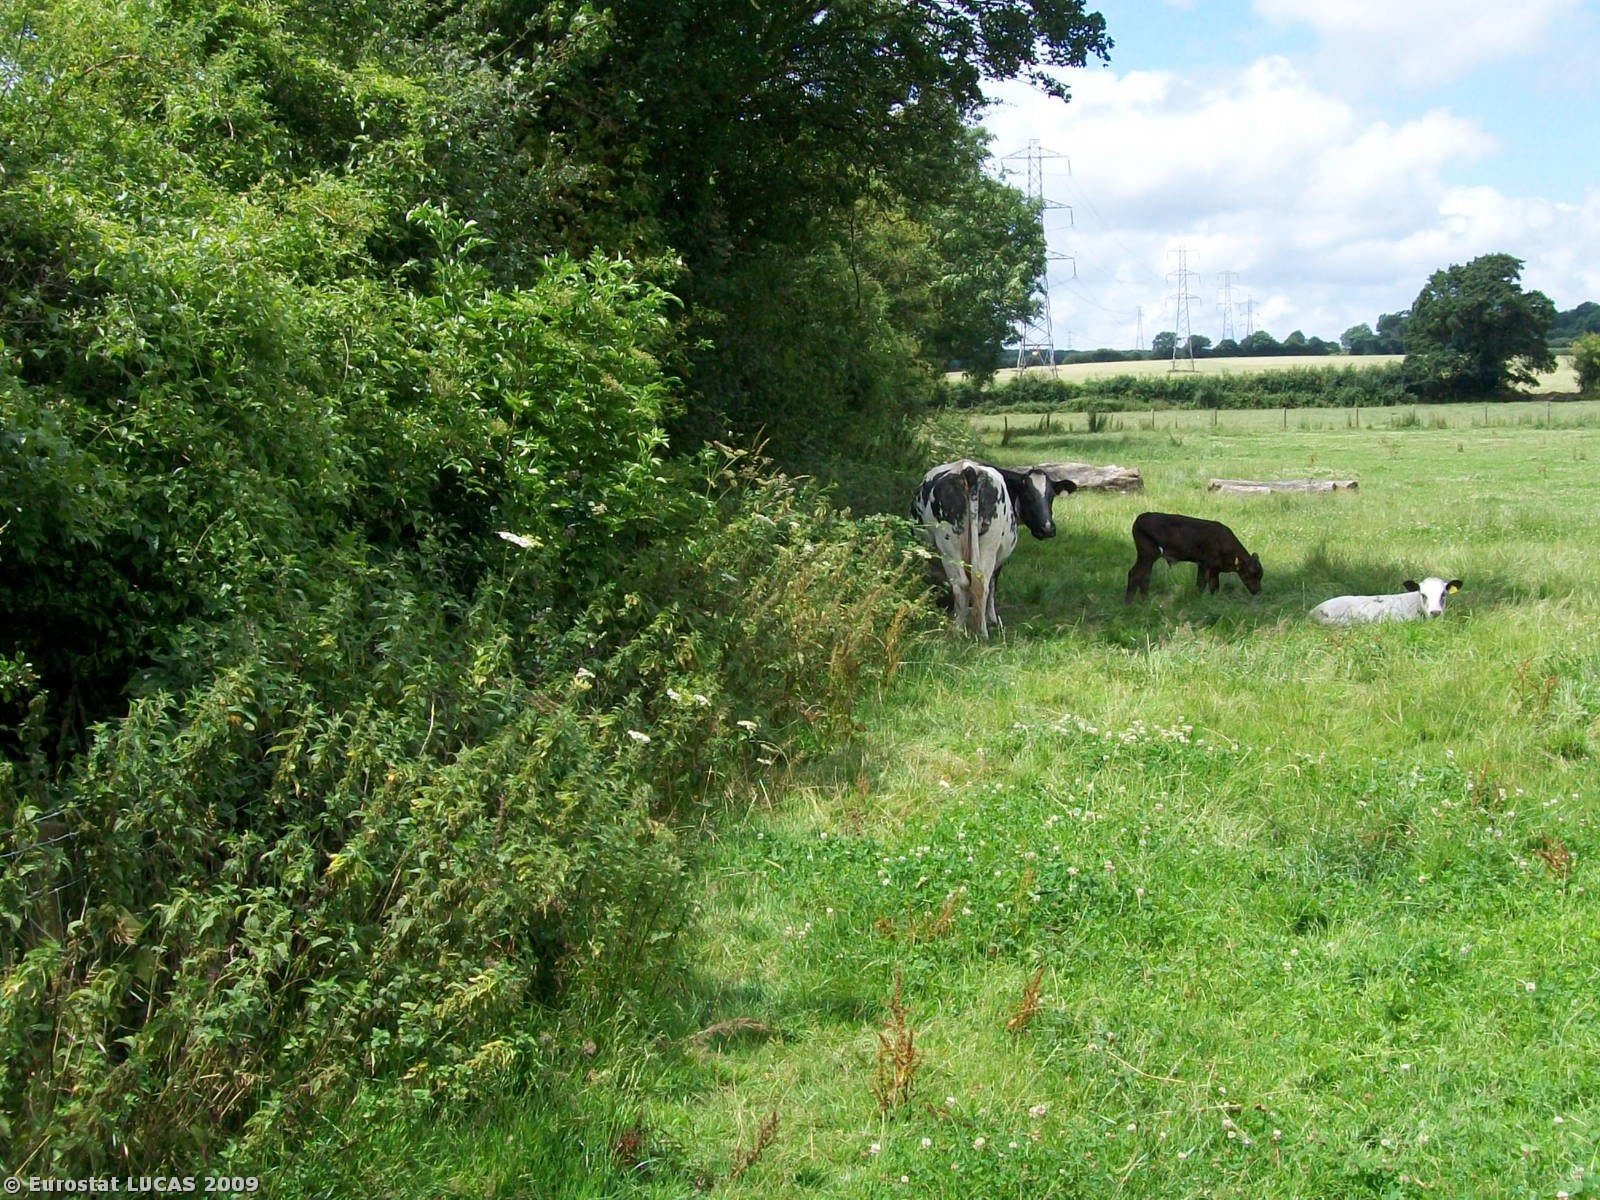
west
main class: Grassland
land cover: Grassland without tree/shrub cover
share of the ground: > 75 %
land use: Agriculture (excluding fallow land and kitchen gardens)
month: July
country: GB
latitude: 51.3959
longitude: -2.2358
